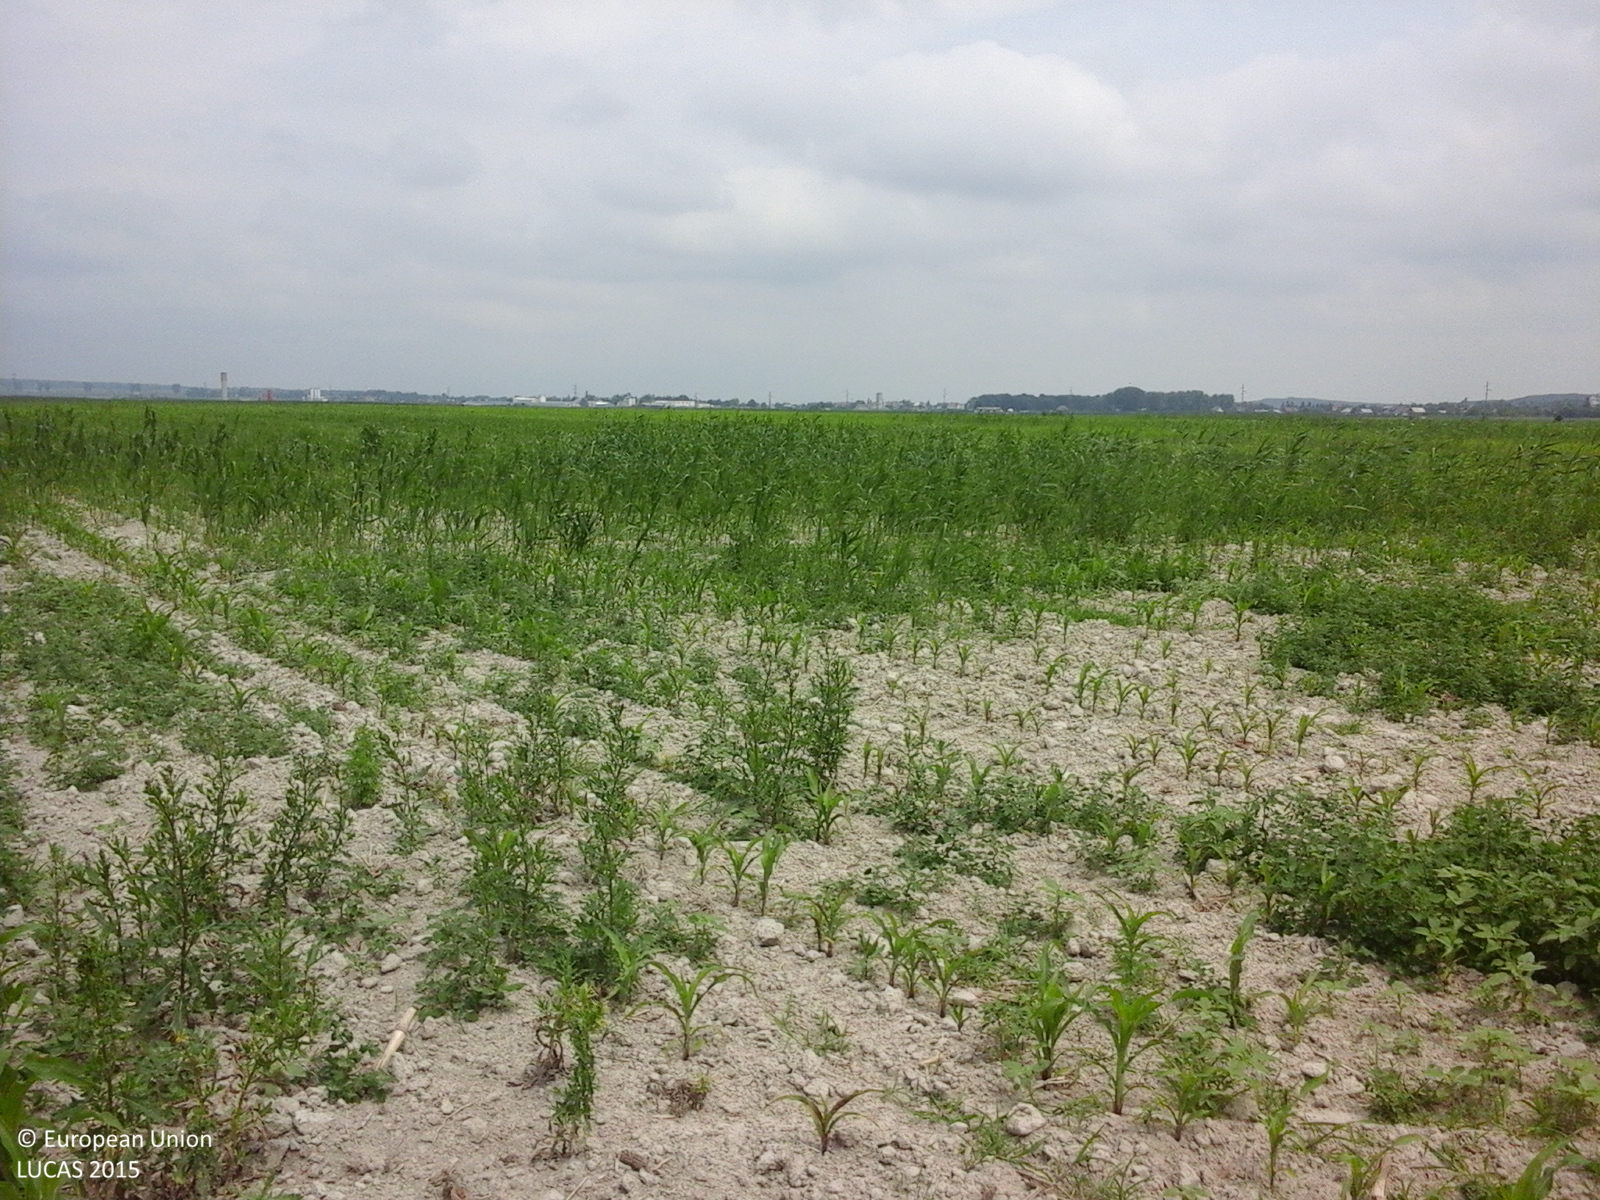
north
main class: Cropland
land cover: Maize
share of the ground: 50 - 75 %
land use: Agriculture (excluding fallow land and kitchen gardens)
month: June
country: RO
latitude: 47.7510
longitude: 26.4285
